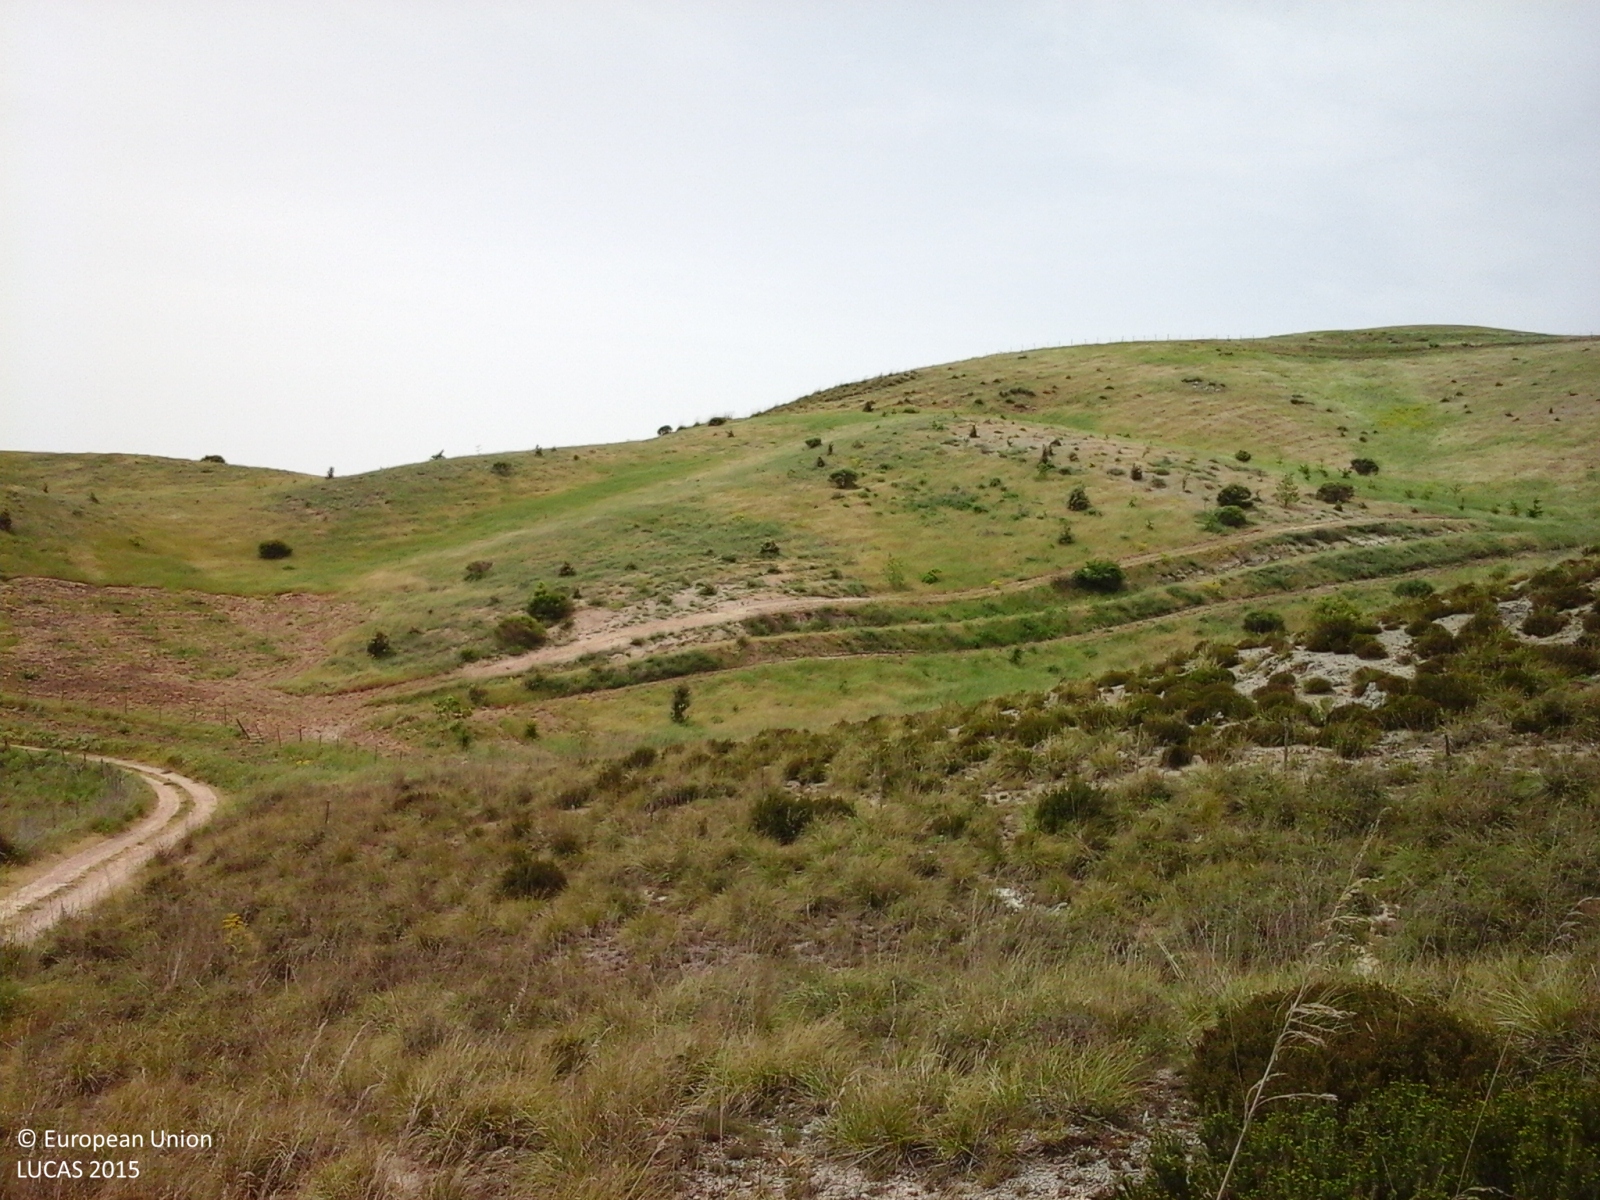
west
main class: Shrubland
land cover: Shrubland without tree cover
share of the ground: > 75 %
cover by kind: herbaceous plants 85 %, shrubs 15 %
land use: Semi-natural and natural areas not in use
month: May
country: IT
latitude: 37.6839
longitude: 13.4781
